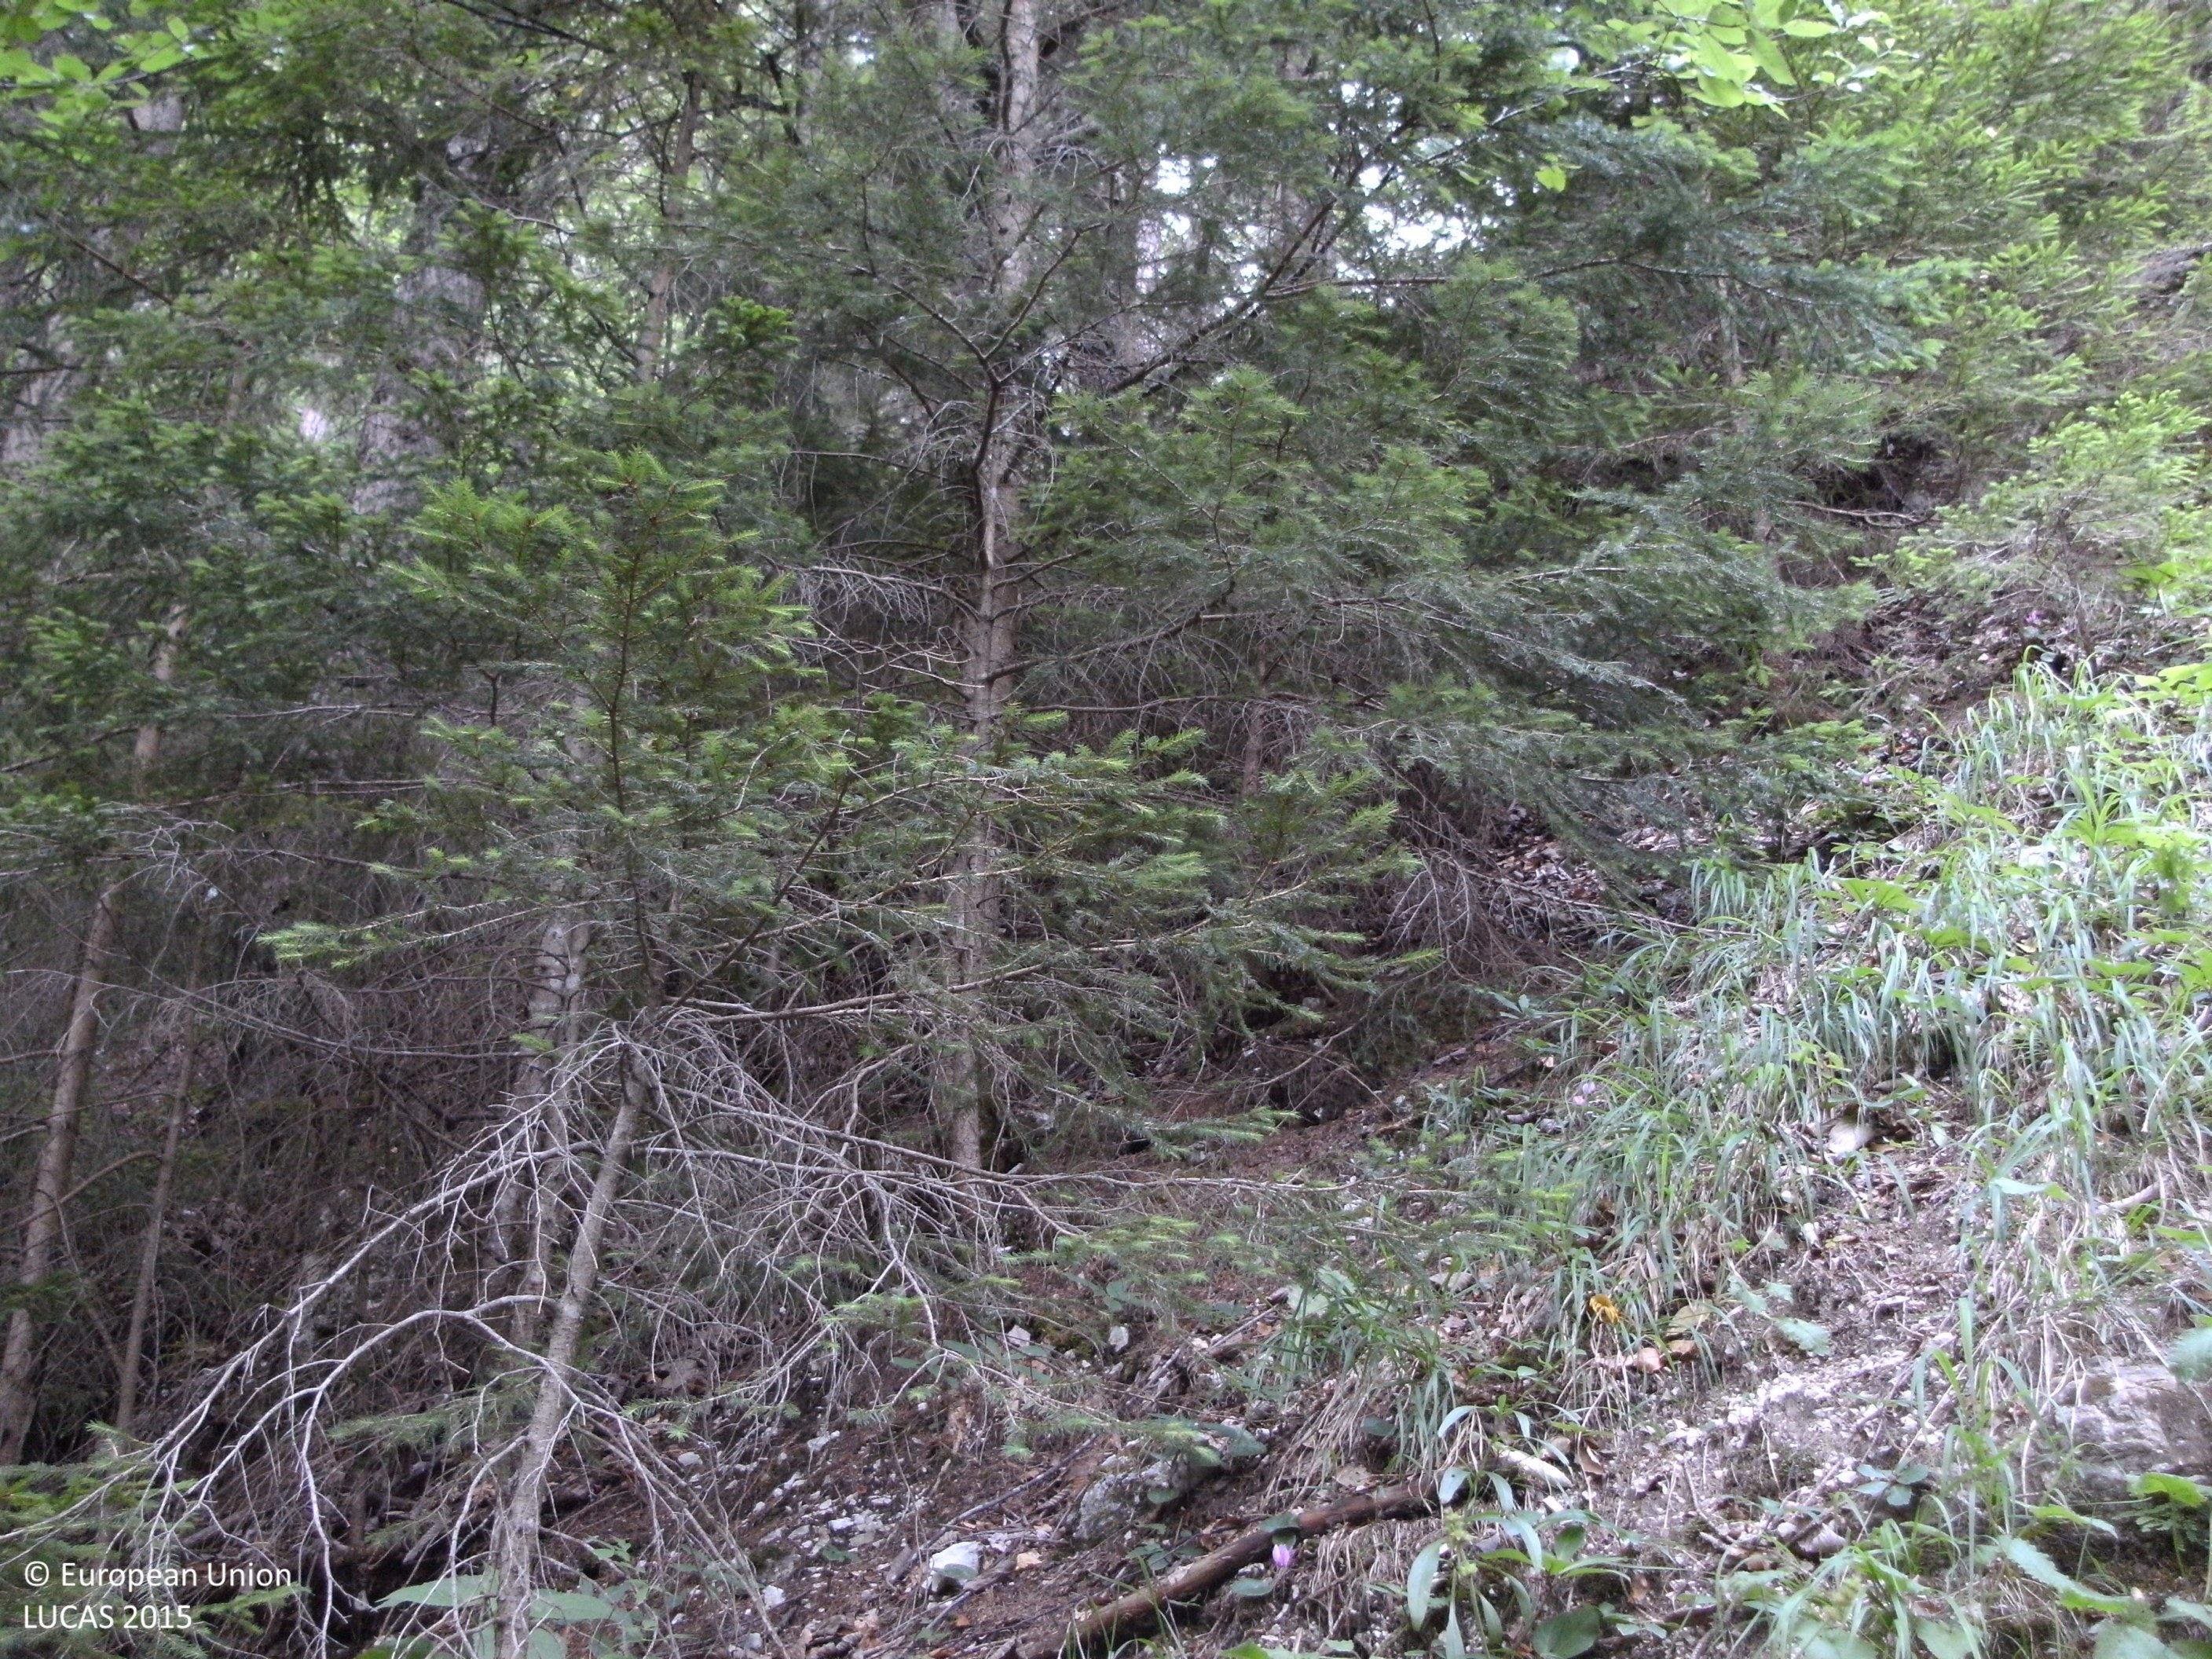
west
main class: Woodland
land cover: Other mixed woodland
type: mountainous beech forest
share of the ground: > 75 %
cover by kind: broadleaved forest trees 50 %, coniferous forest trees 45 %, consolidated bare surface 5 %
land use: Forestry
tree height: > 5 m
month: July
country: AT
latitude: 46.3982
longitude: 14.5623
